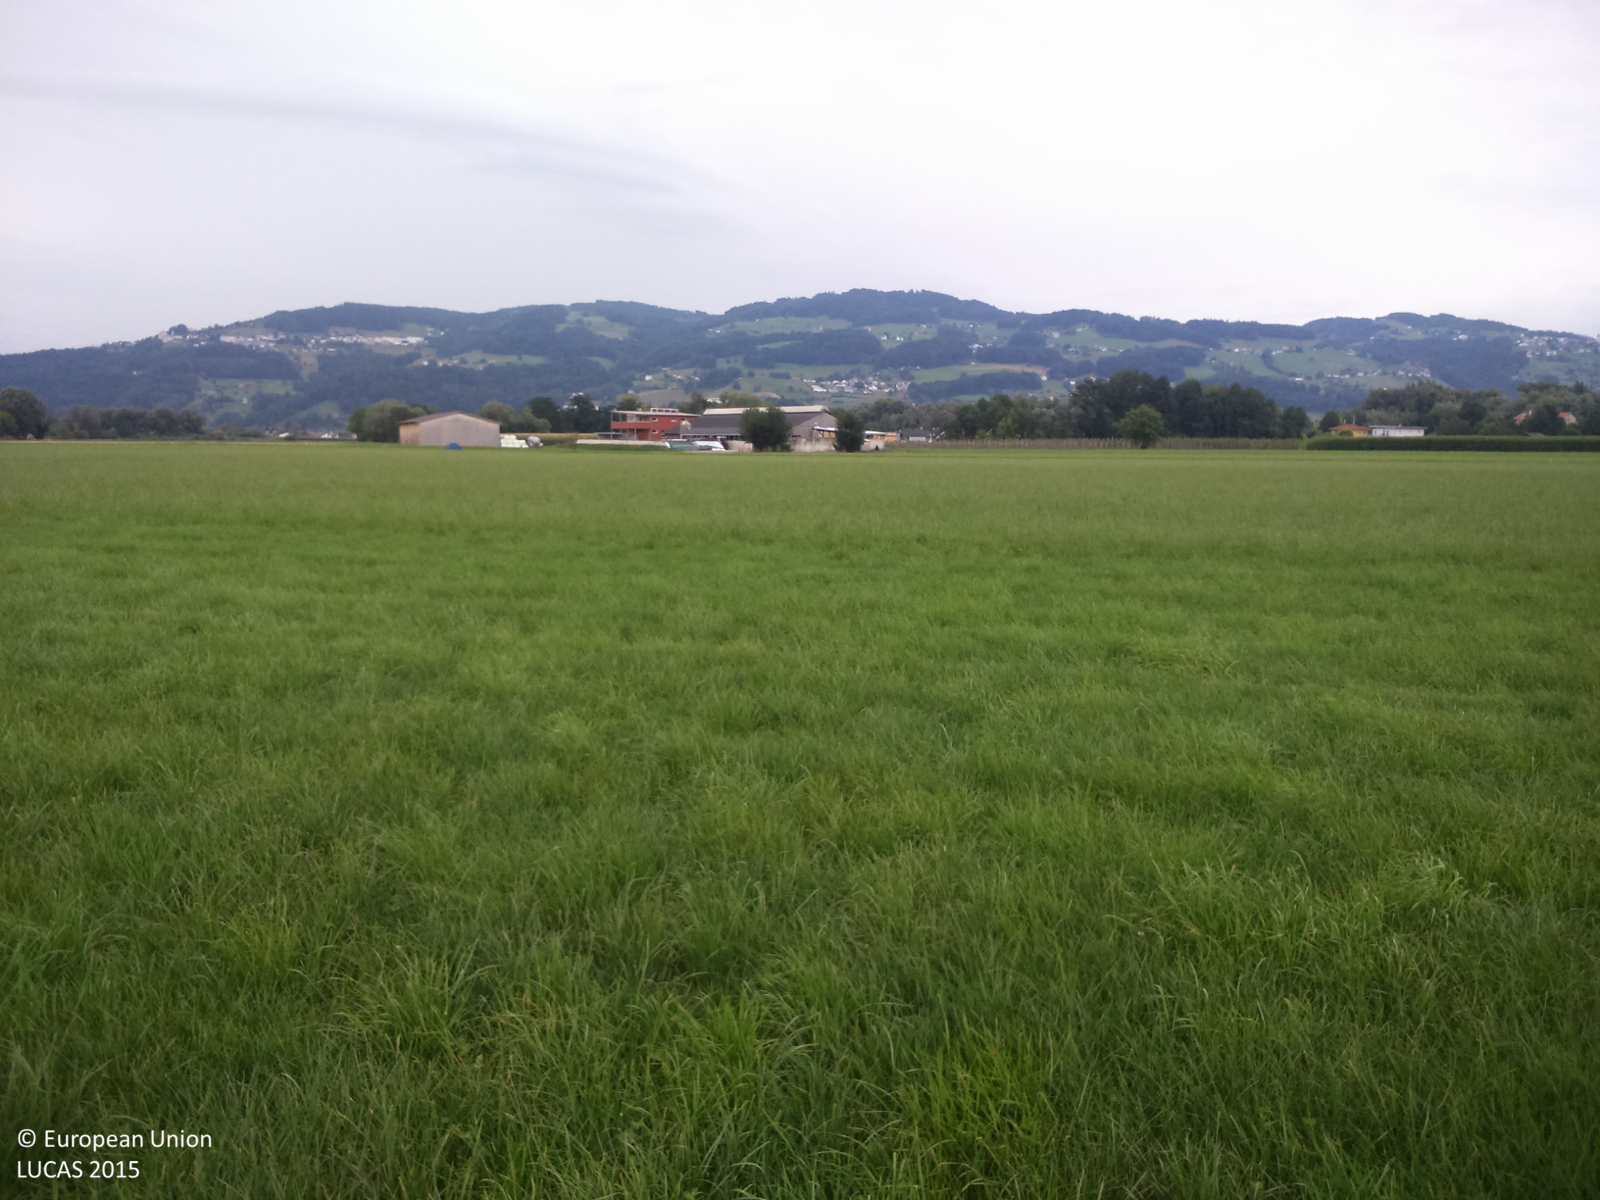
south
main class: Grassland
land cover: Grassland without tree/shrub cover
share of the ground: > 75 %
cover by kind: herbaceous plants 100 %
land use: Agriculture (excluding fallow land and kitchen gardens)
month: August
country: AT
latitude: 47.4848
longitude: 9.5890
